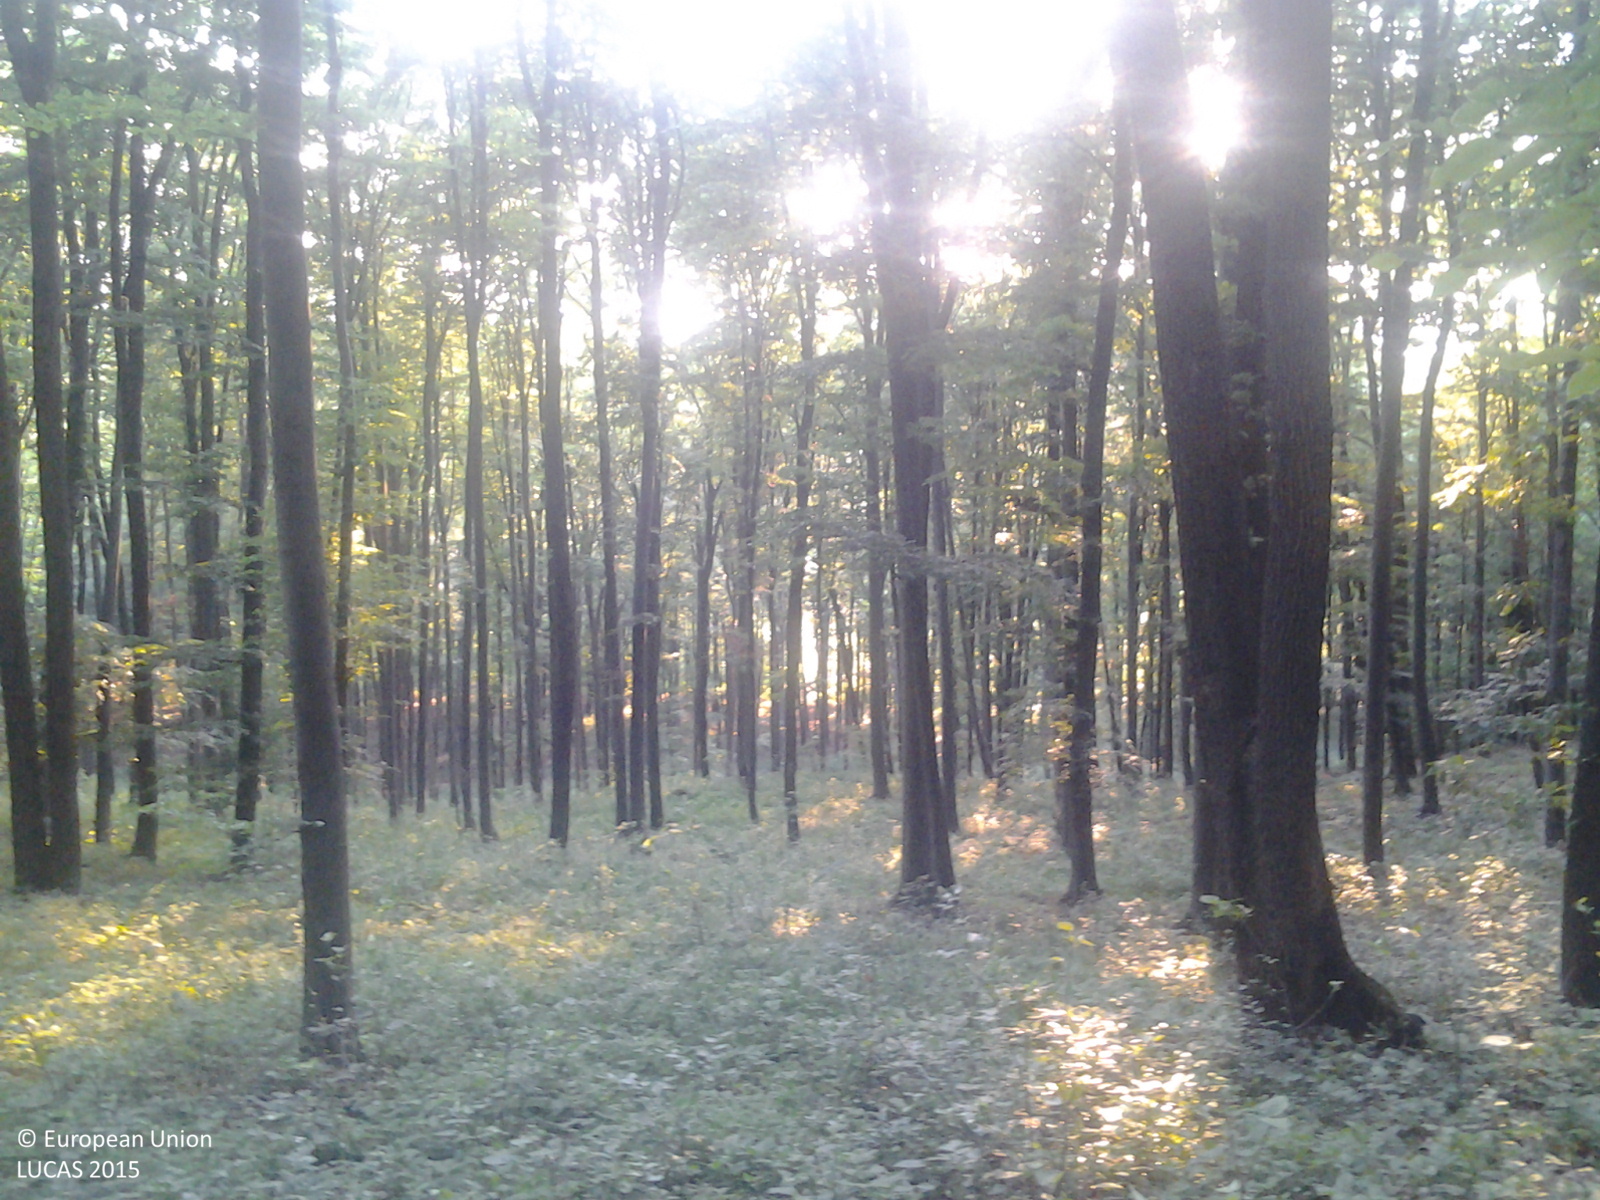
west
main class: Woodland
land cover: Broadleaved woodland
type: beech forest
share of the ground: > 75 %
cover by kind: broadleaved forest trees 100 %
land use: Forestry
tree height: > 5 m
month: June
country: RO
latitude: 46.3491
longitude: 27.1610
